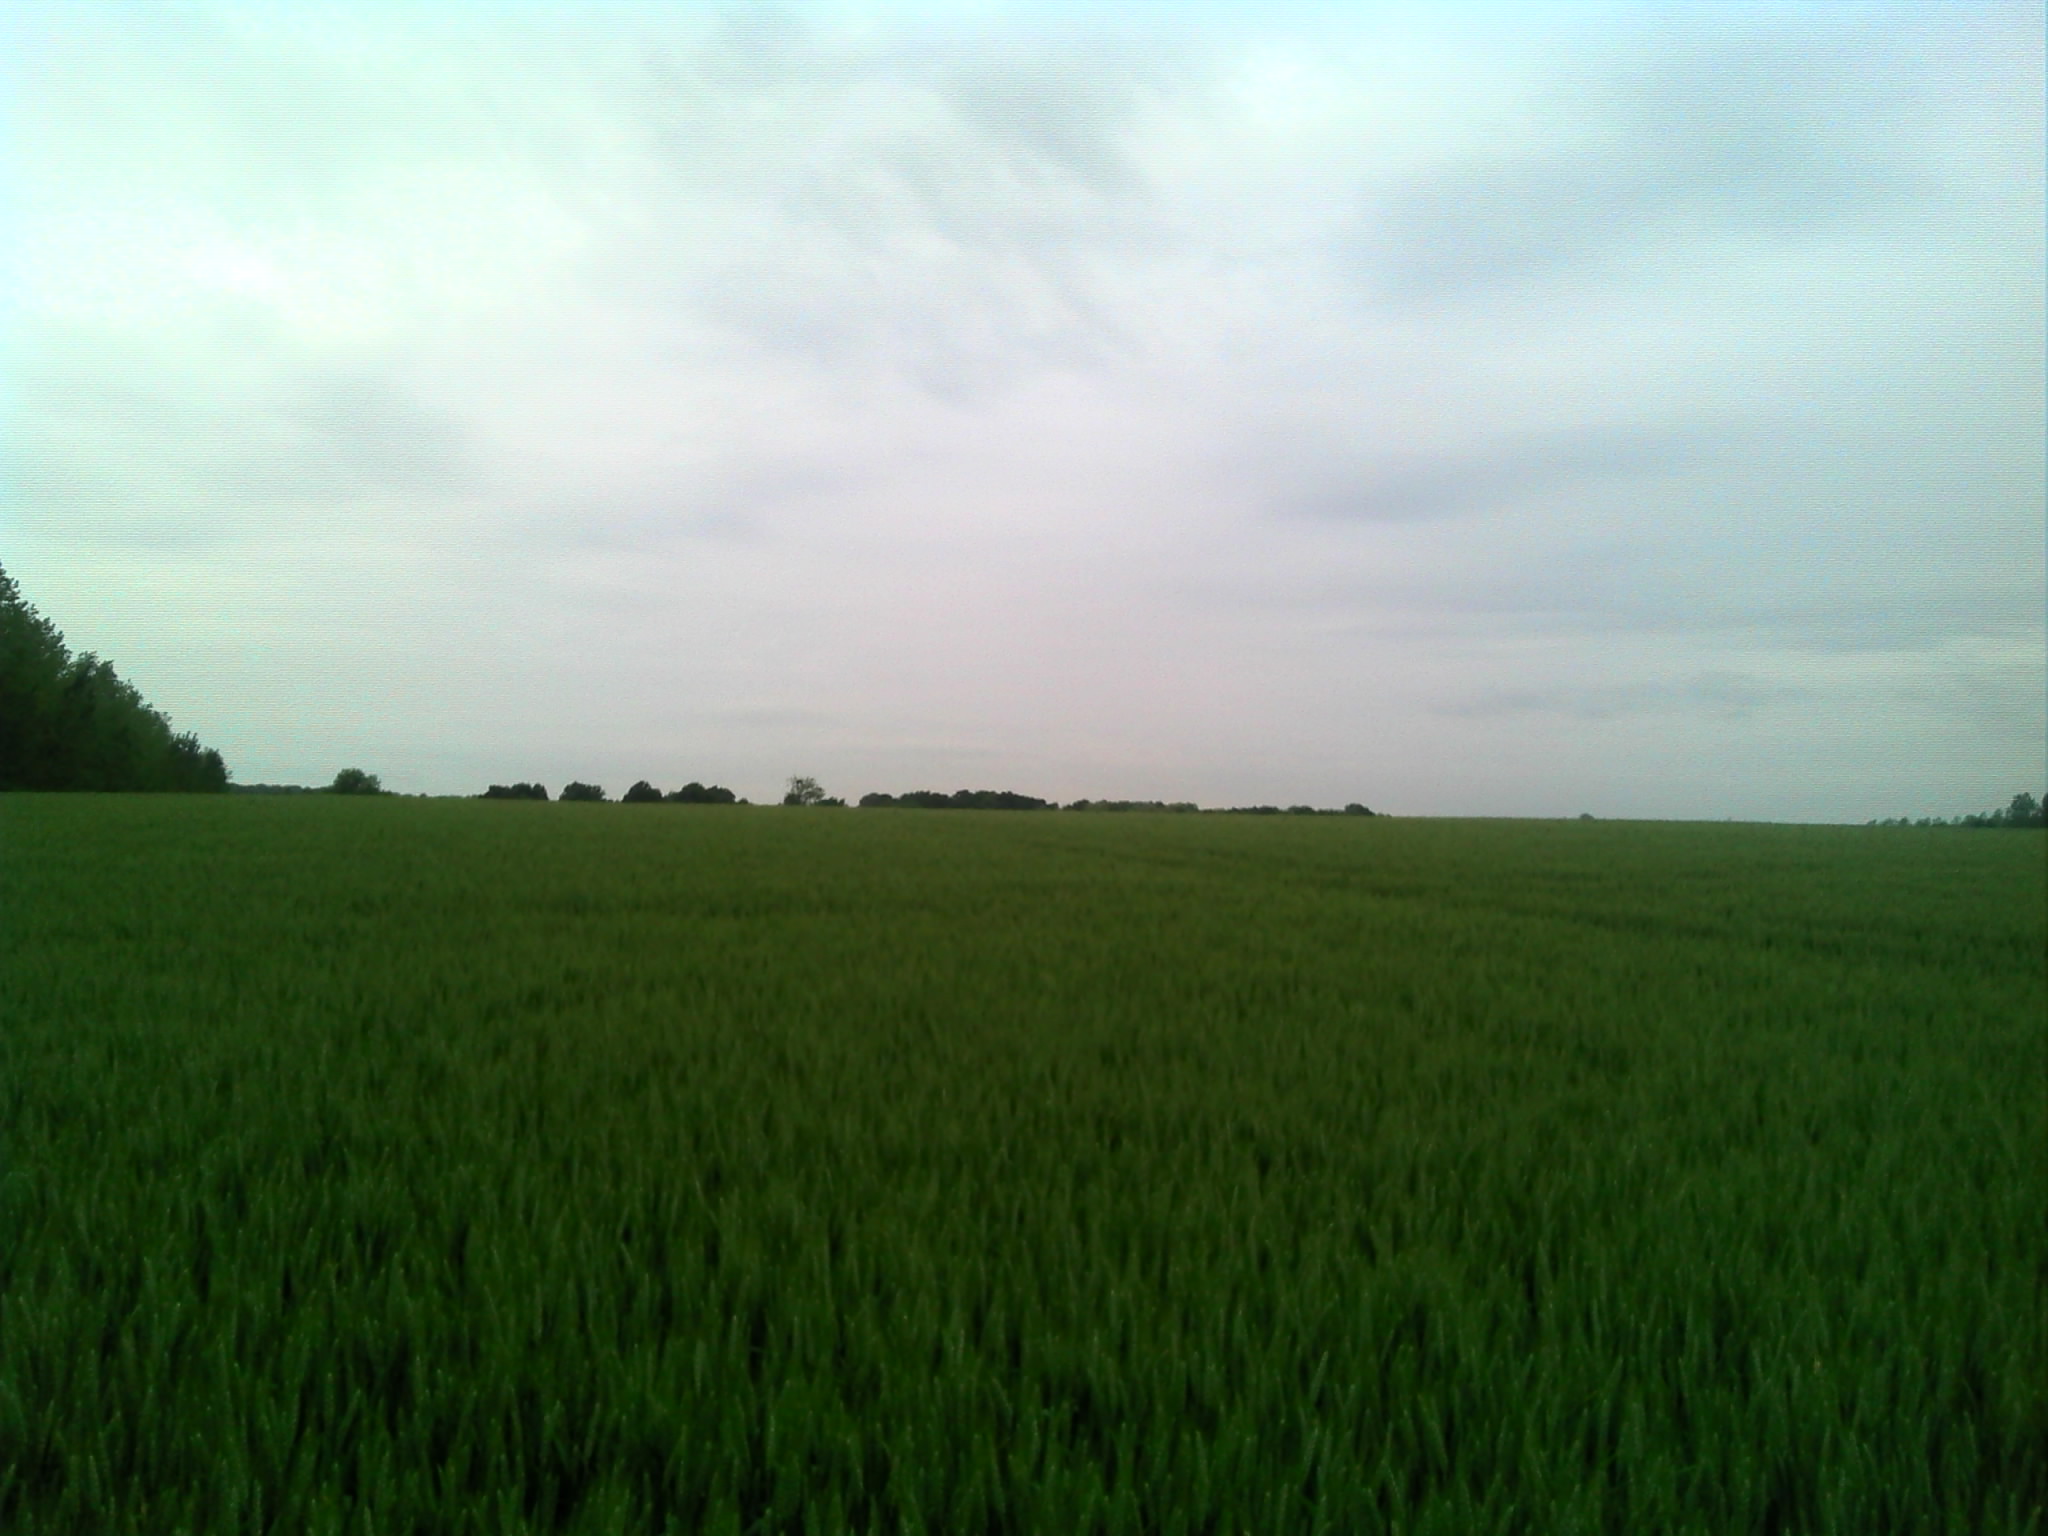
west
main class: Cropland
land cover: Common wheat
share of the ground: > 75 %
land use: Agriculture (excluding fallow land and kitchen gardens)
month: June
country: FR
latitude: 49.7144
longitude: 3.2653
